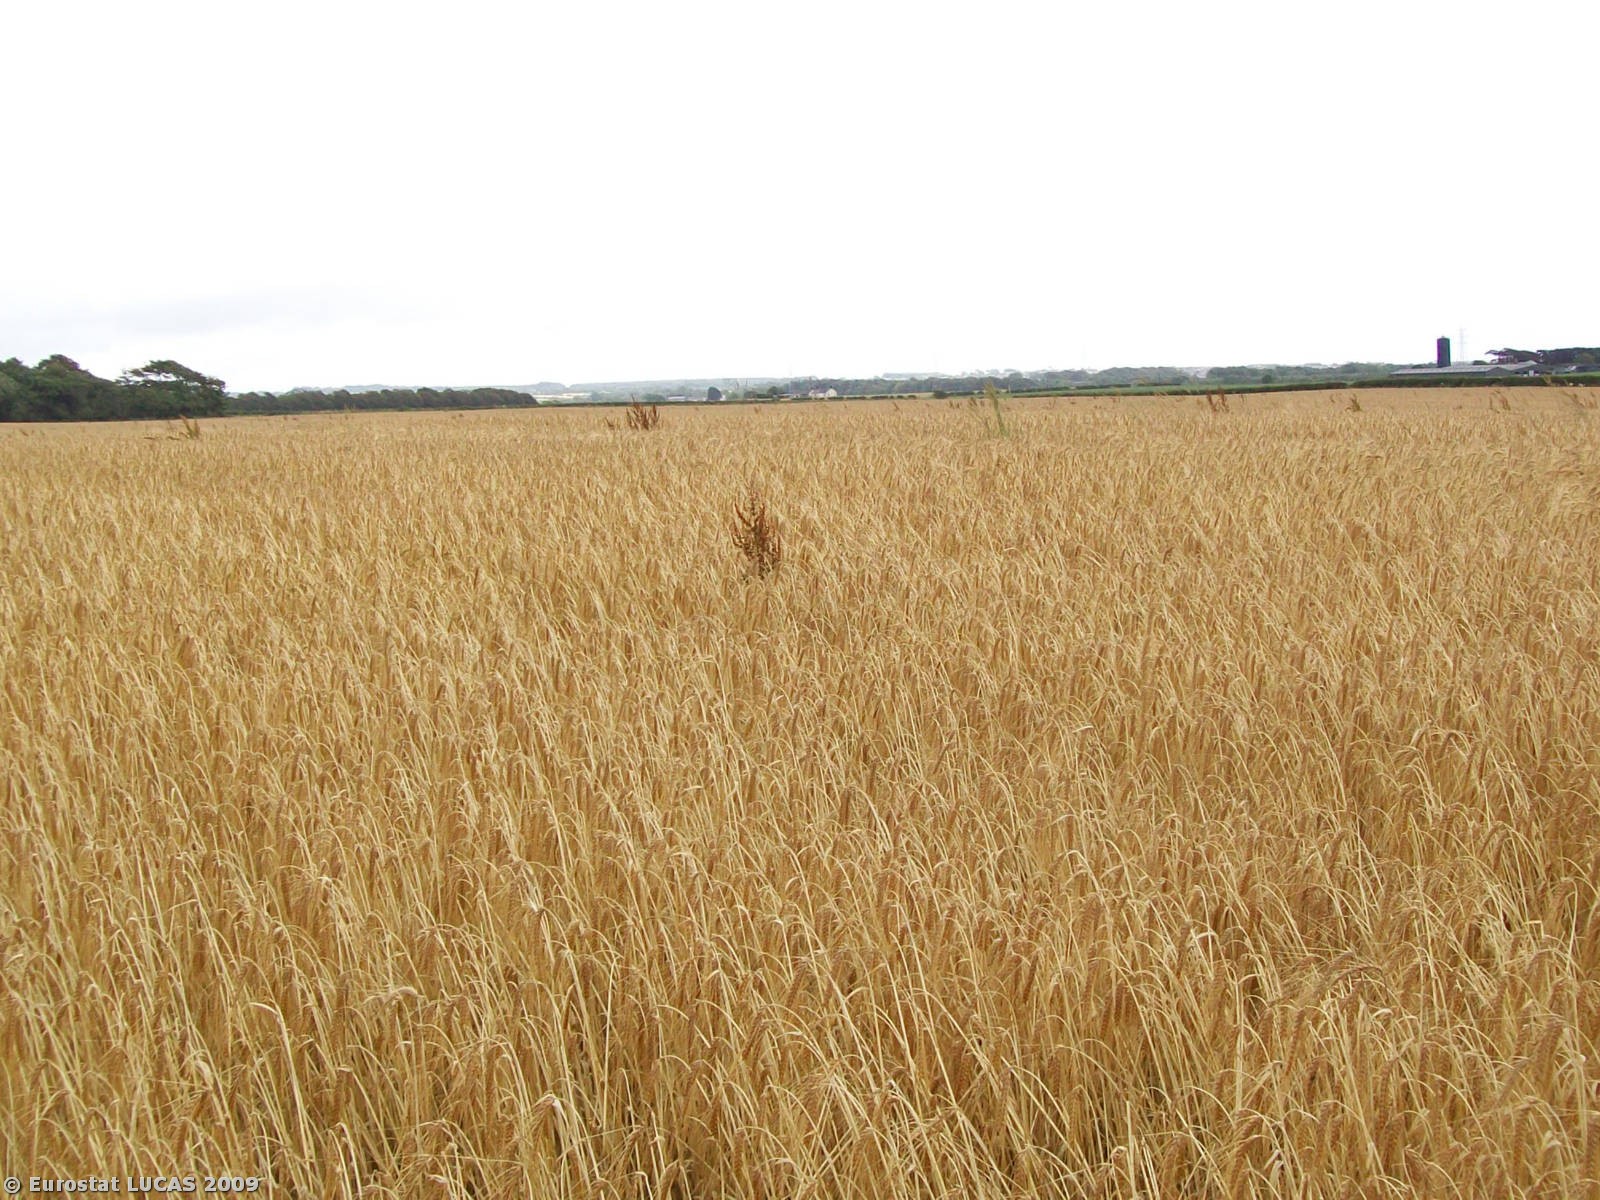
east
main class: Cropland
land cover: Barley
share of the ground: > 75 %
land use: Agriculture (excluding fallow land and kitchen gardens)
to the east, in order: Barley
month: July
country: GB
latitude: 54.9968
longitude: -3.3172
